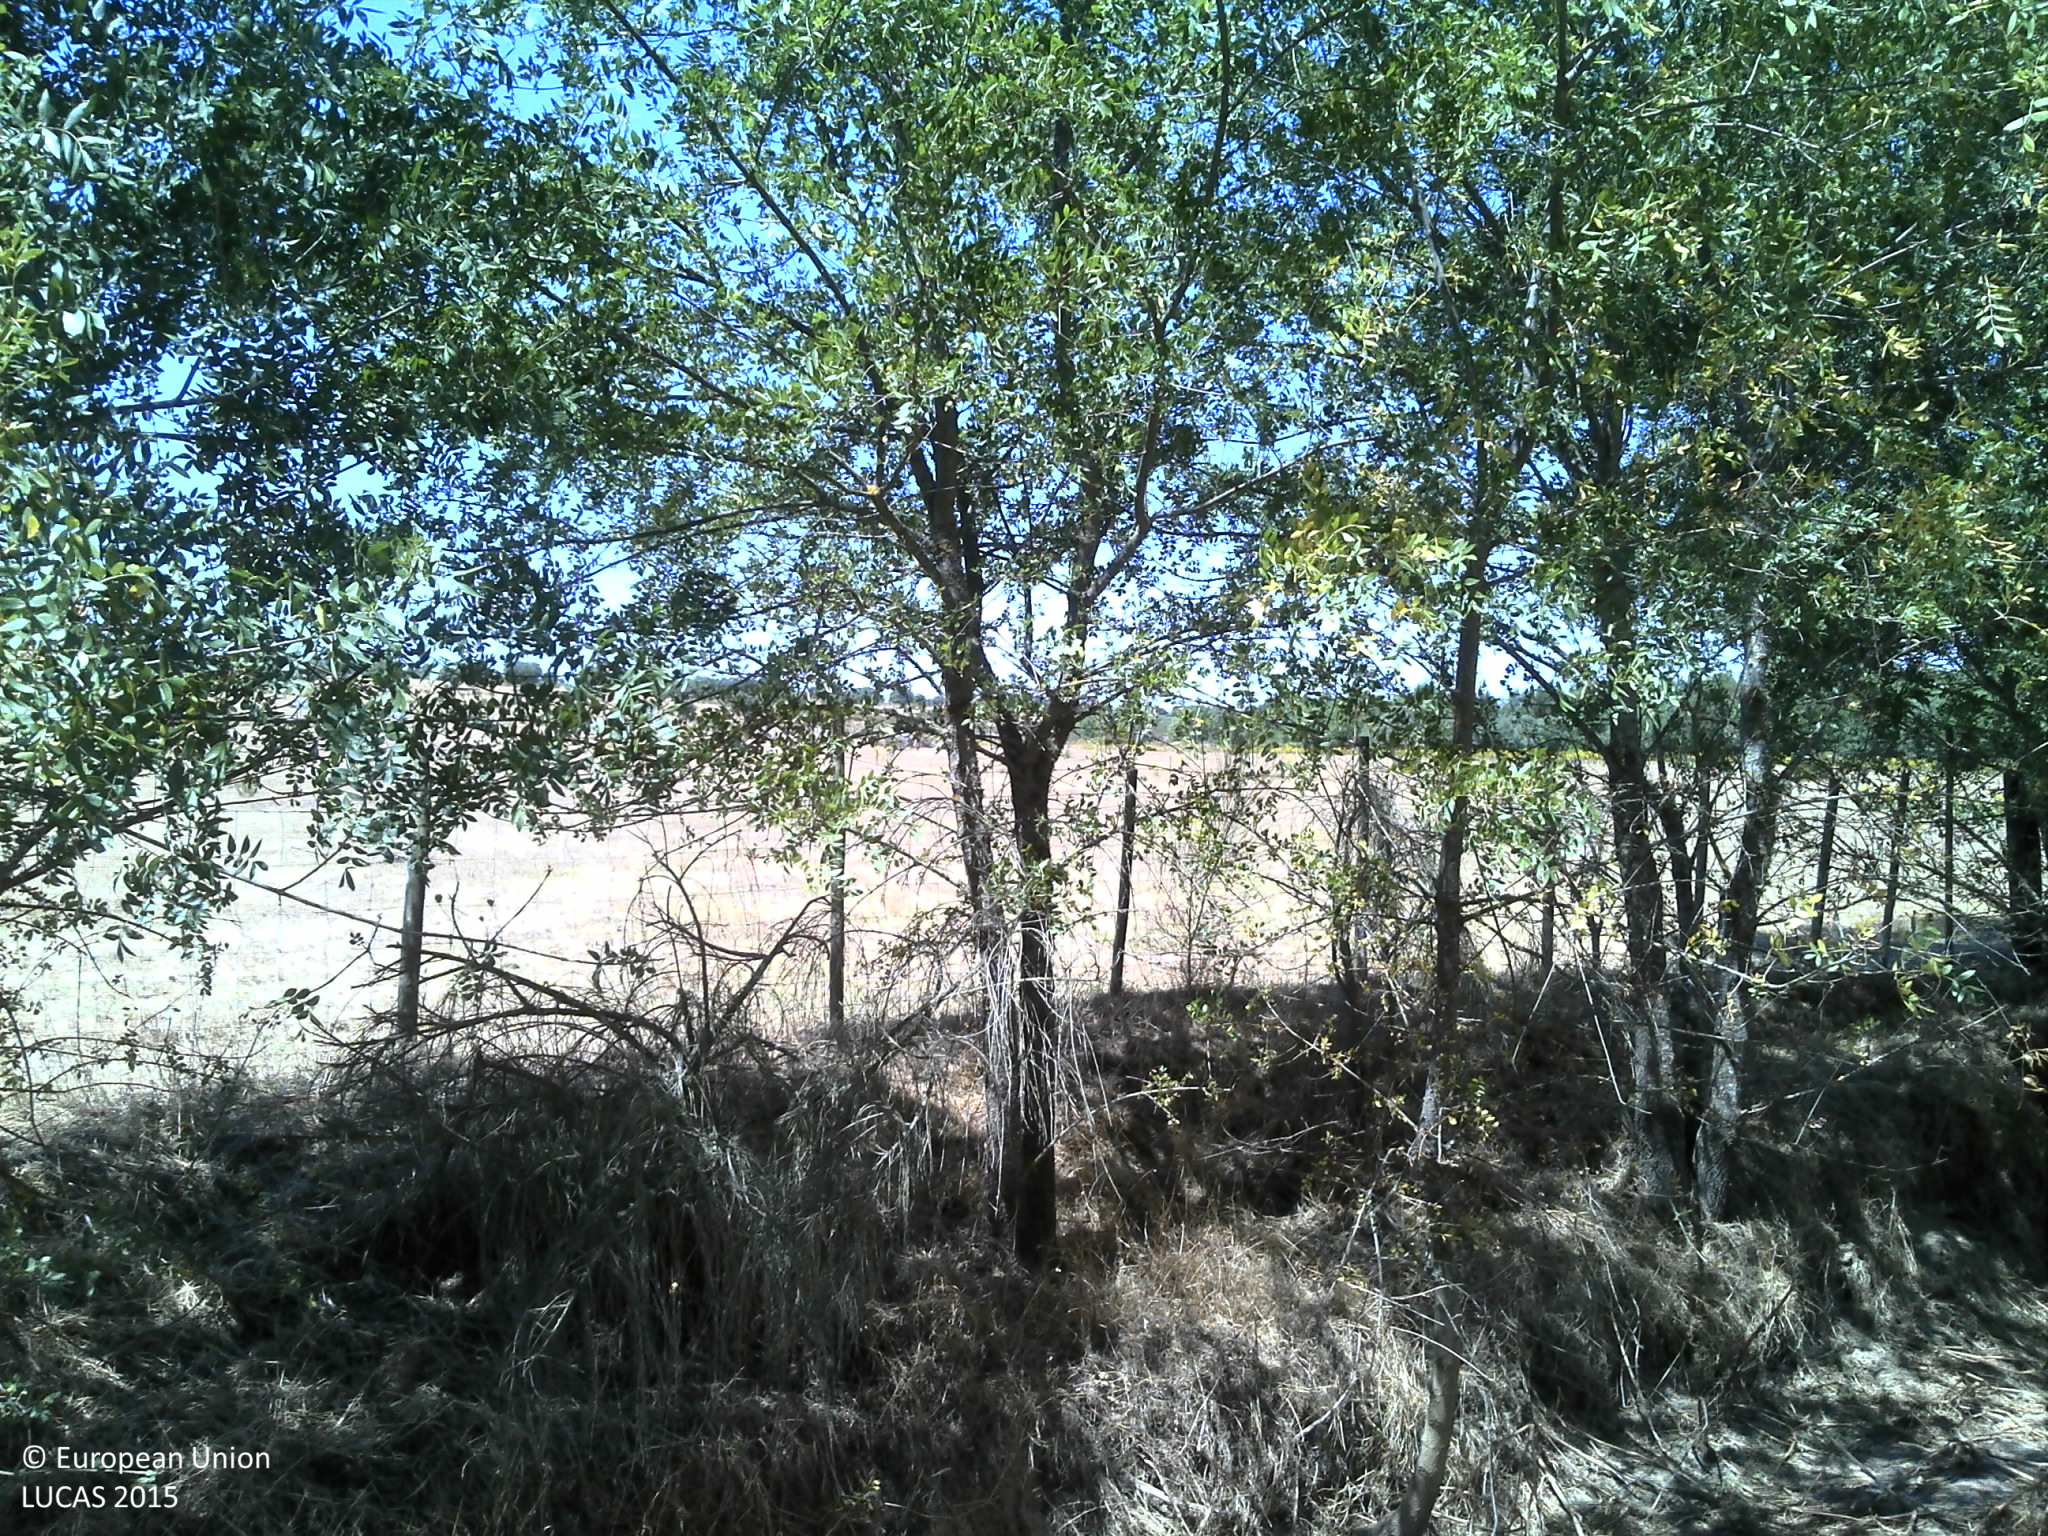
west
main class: Woodland
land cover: Broadleaved woodland
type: broadleaved evergreen forest
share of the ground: 25 - 50 %
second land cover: Grassland without tree/shrub cover
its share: 25 - 50 %
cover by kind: unconsolidated bare surface 40 %, broadleaved forest trees 30 %, herbaceous plants 25 %, shrubs 5 %
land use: Forestry
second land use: Agriculture (excluding fallow land and kitchen gardens)
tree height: > 5 m
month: July
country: PT
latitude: 39.3592
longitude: -7.7250
